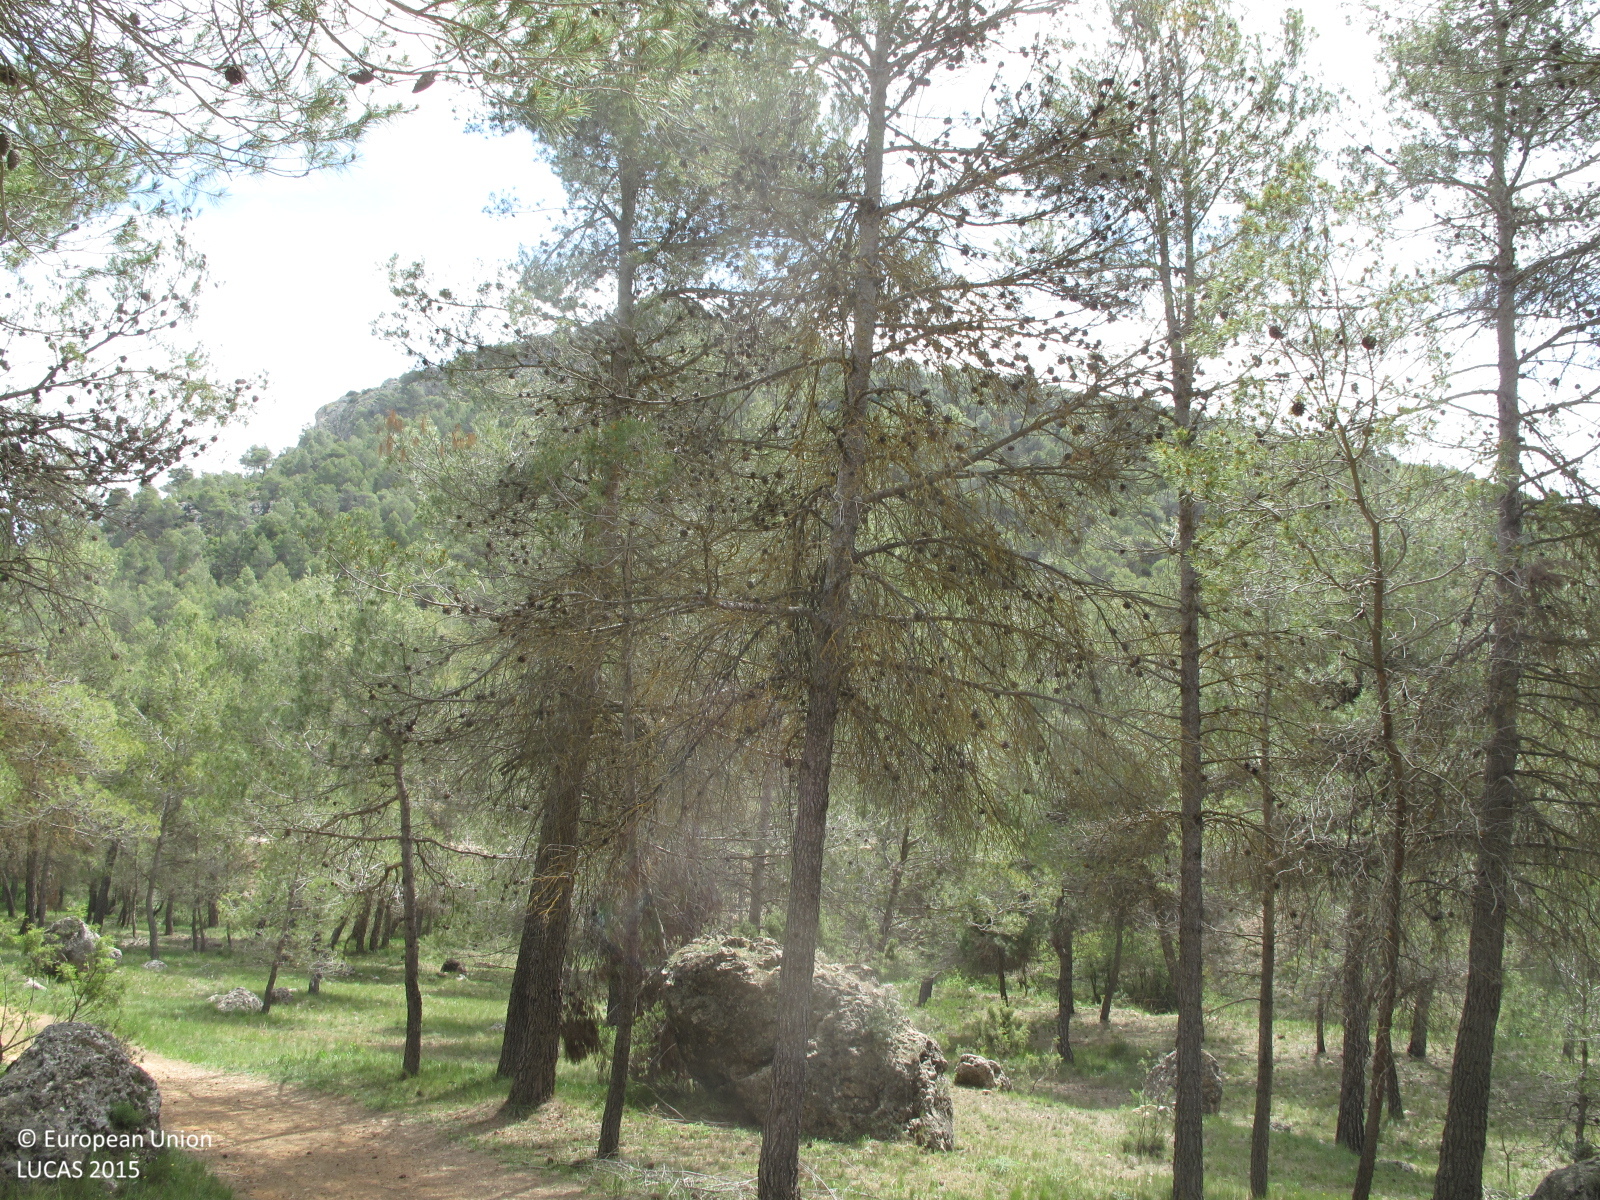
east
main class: Woodland
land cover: Pine dominated coniferous woodland
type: coniferous forest of the mediterranean region
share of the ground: 50 - 75 %
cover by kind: coniferous forest trees 50 %, consolidated bare surface 25 %, herbaceous plants 20 %, shrubs 5 %
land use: Semi-natural and natural areas not in use
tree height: > 5 m
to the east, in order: Pine dominated coniferous woodland; Tracks; Pine dominated coniferous woodland; Tracks; Rock outcrops; Pine dominated coniferous woodland
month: May
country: ES
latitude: 38.7492
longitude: -0.5413
